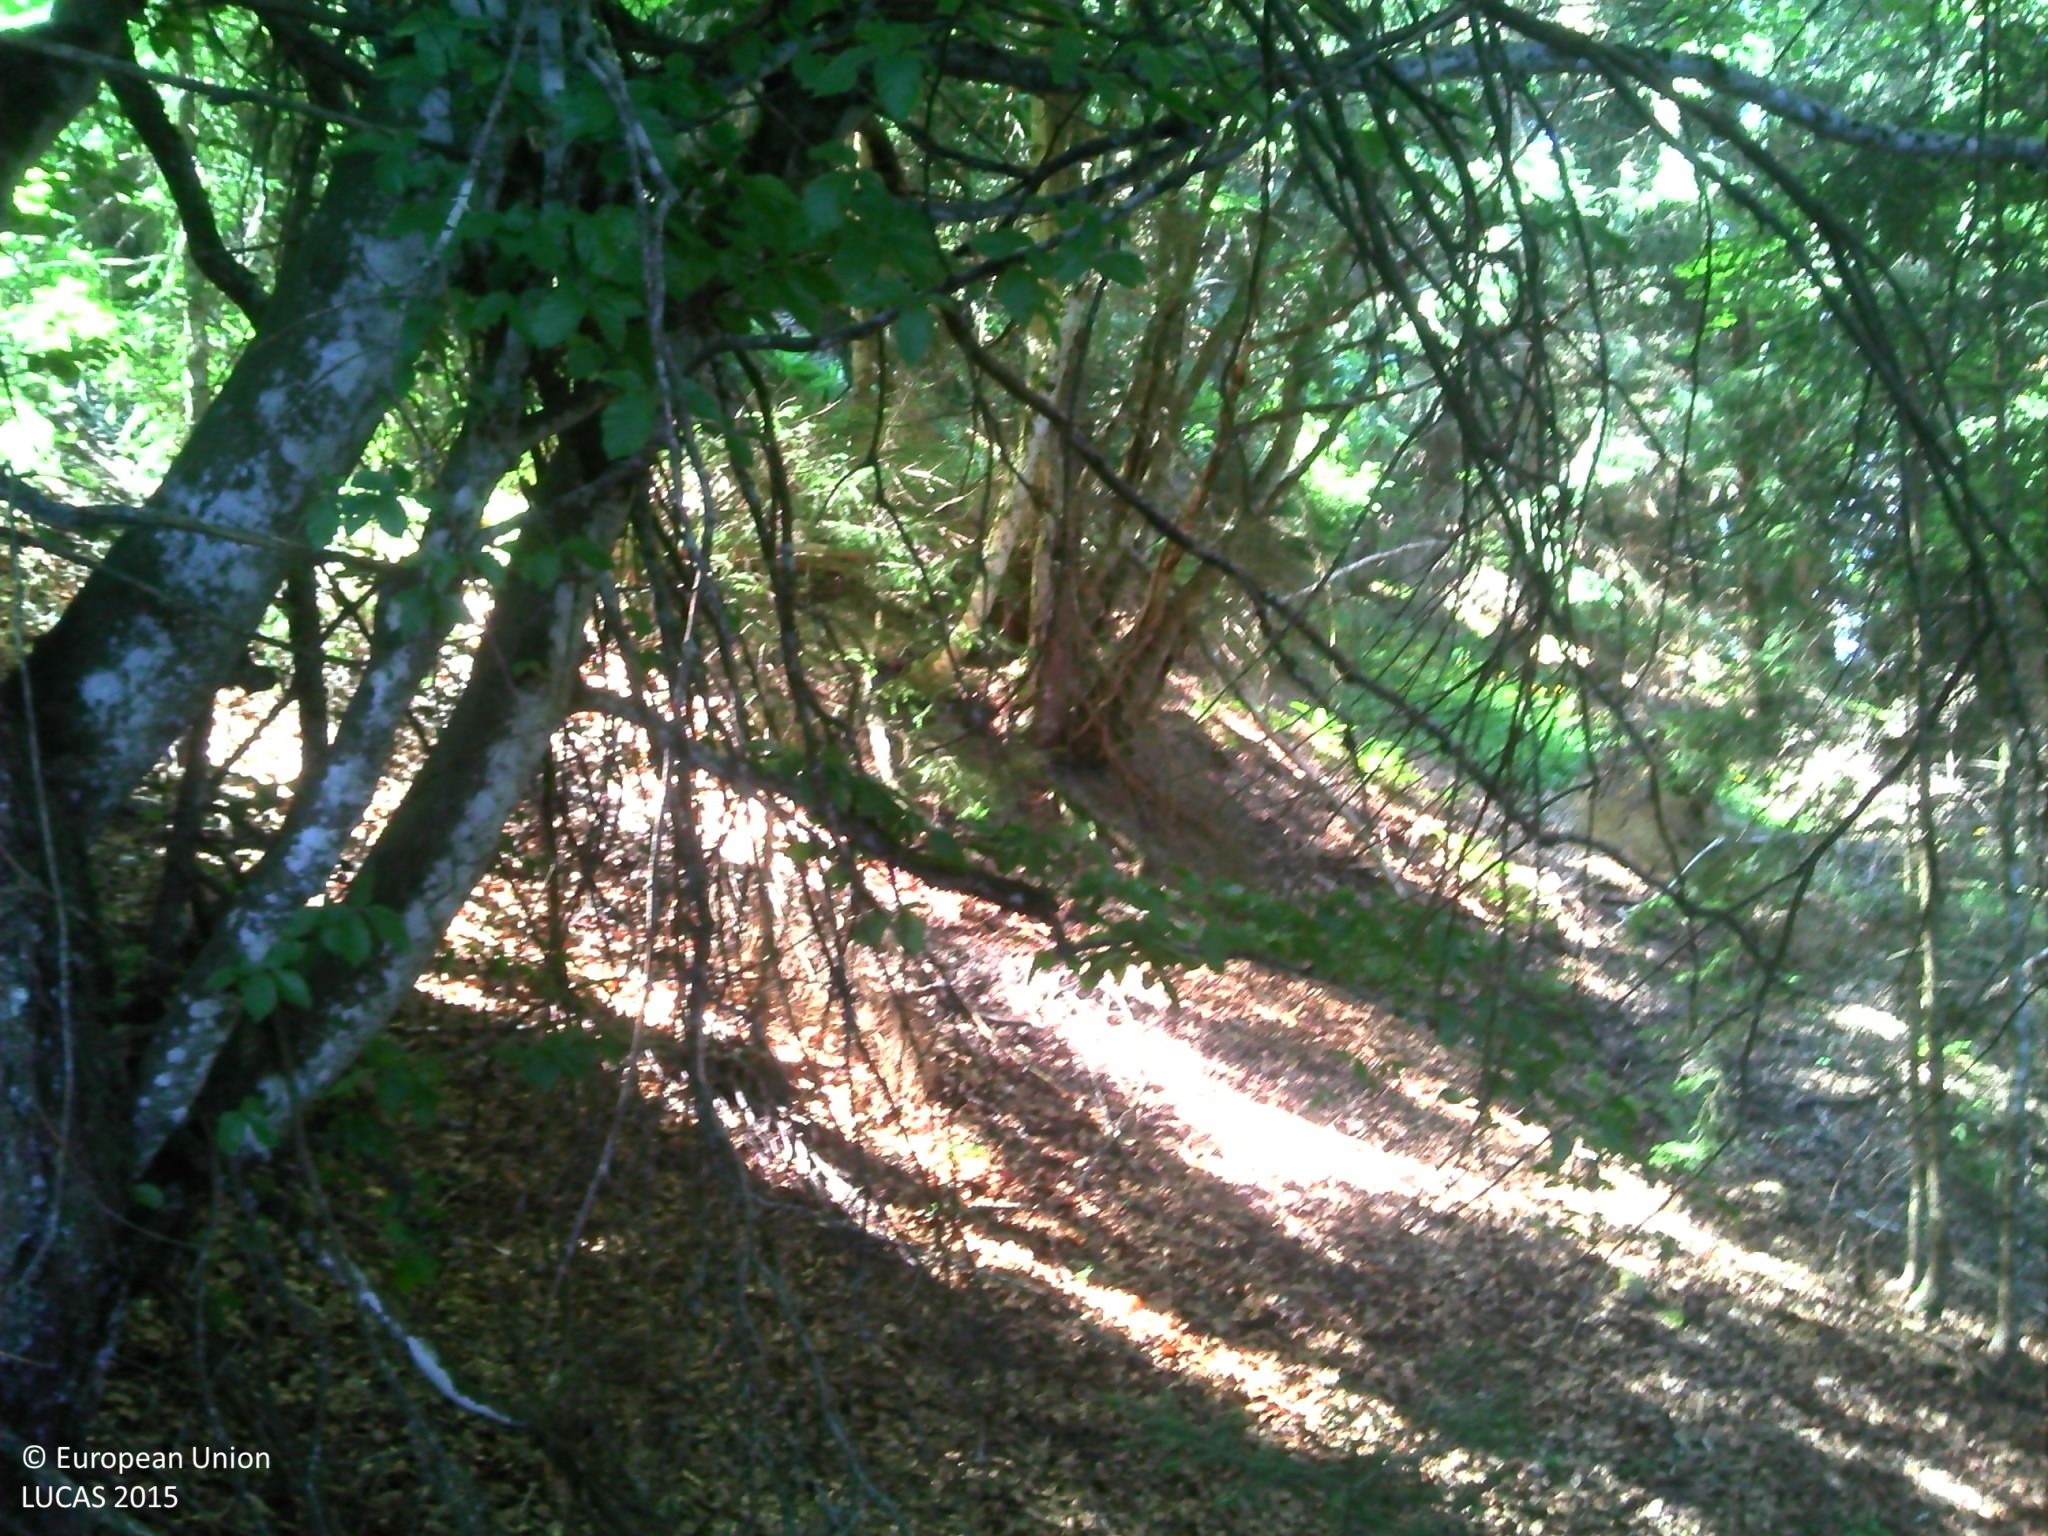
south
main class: Woodland
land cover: Spruce dominated mixed woodland
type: mountainous beech forest
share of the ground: > 75 %
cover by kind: coniferous forest trees 50 %, broadleaved forest trees 30 %, herbaceous plants 15 %, lichens and mosses 5 %
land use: Forestry
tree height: > 5 m
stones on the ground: 10 - 25 %
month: July
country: FR
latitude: 45.7593
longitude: 6.1600
